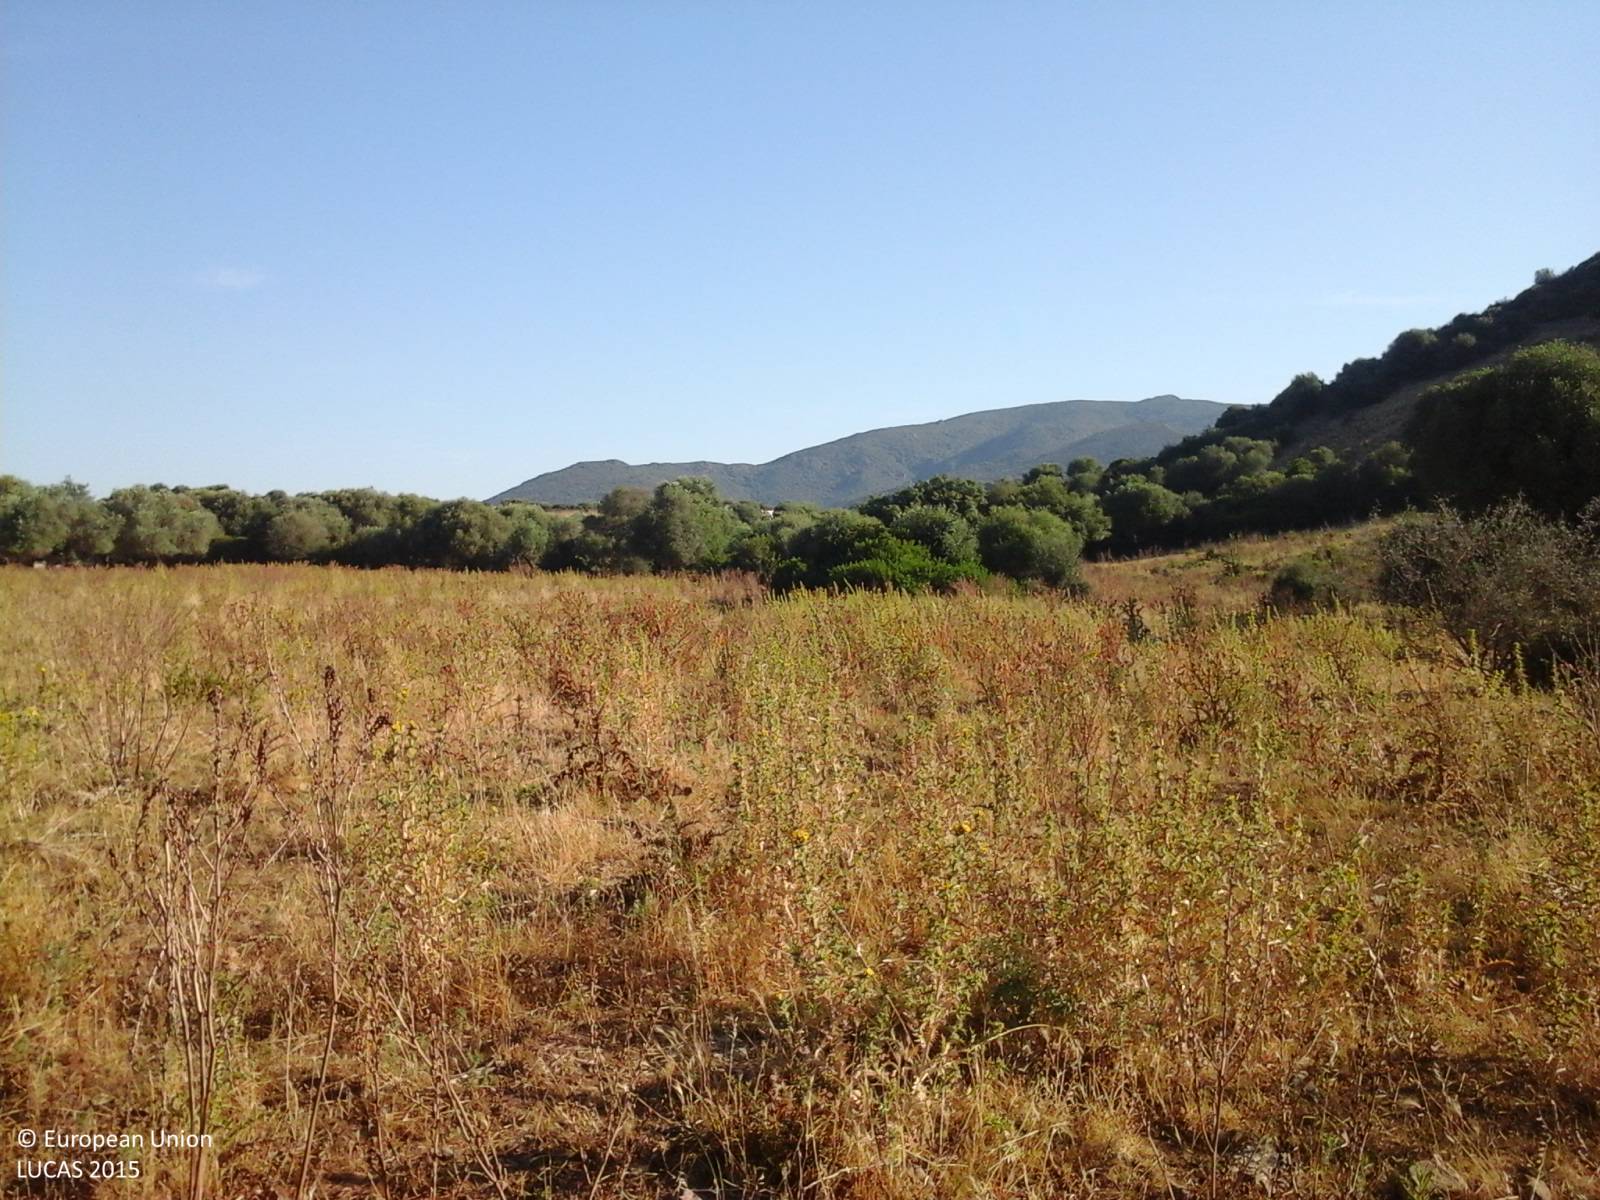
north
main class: Grassland
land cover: Grassland with sparse tree/shrub cover
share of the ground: 50 - 75 %
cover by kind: herbaceous plants 75 %, shrubs 10 %, unconsolidated bare surface 10 %, broadleaved forest trees 5 %
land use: Agriculture (excluding fallow land and kitchen gardens)
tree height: < 5 m
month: June
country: IT
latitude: 40.9127
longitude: 8.9010
